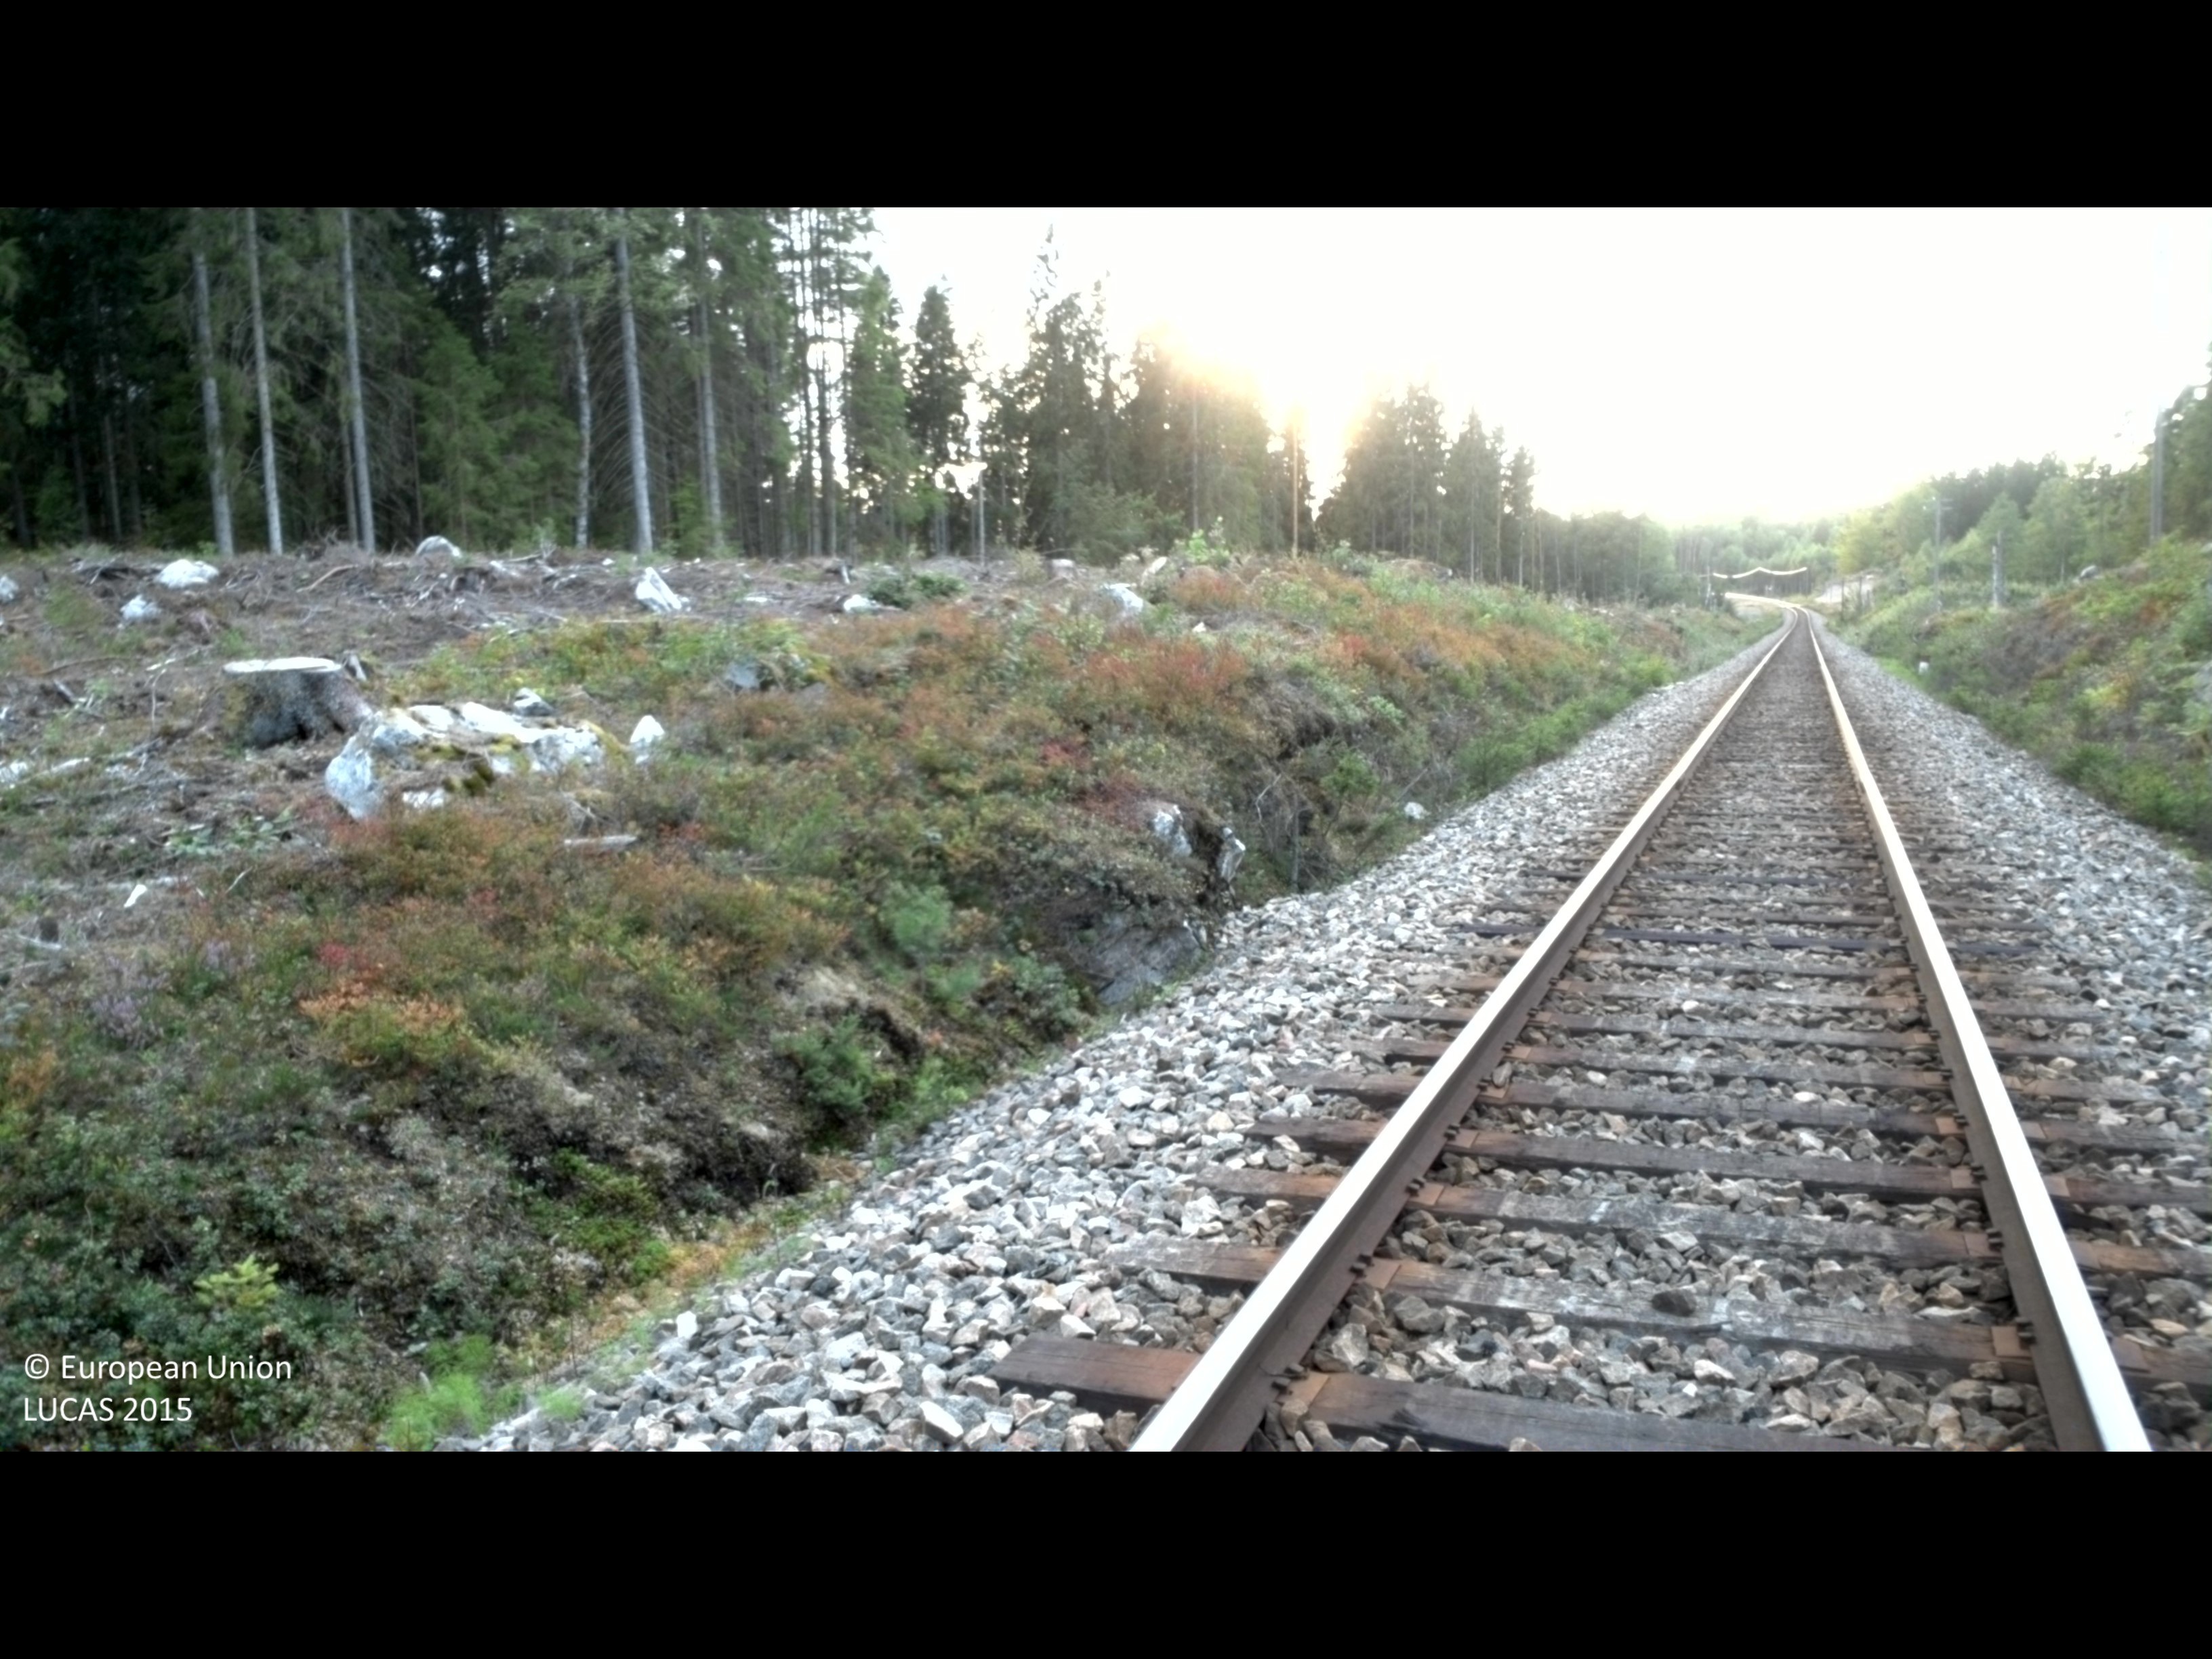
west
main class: Shrubland
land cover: Shrubland with sparse tree cover
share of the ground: > 75 %
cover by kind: shrubs 90 %, coniferous forest trees 5 %
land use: Forestry
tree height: < 5 m
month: August
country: SE
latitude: 56.3639
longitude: 14.4168
